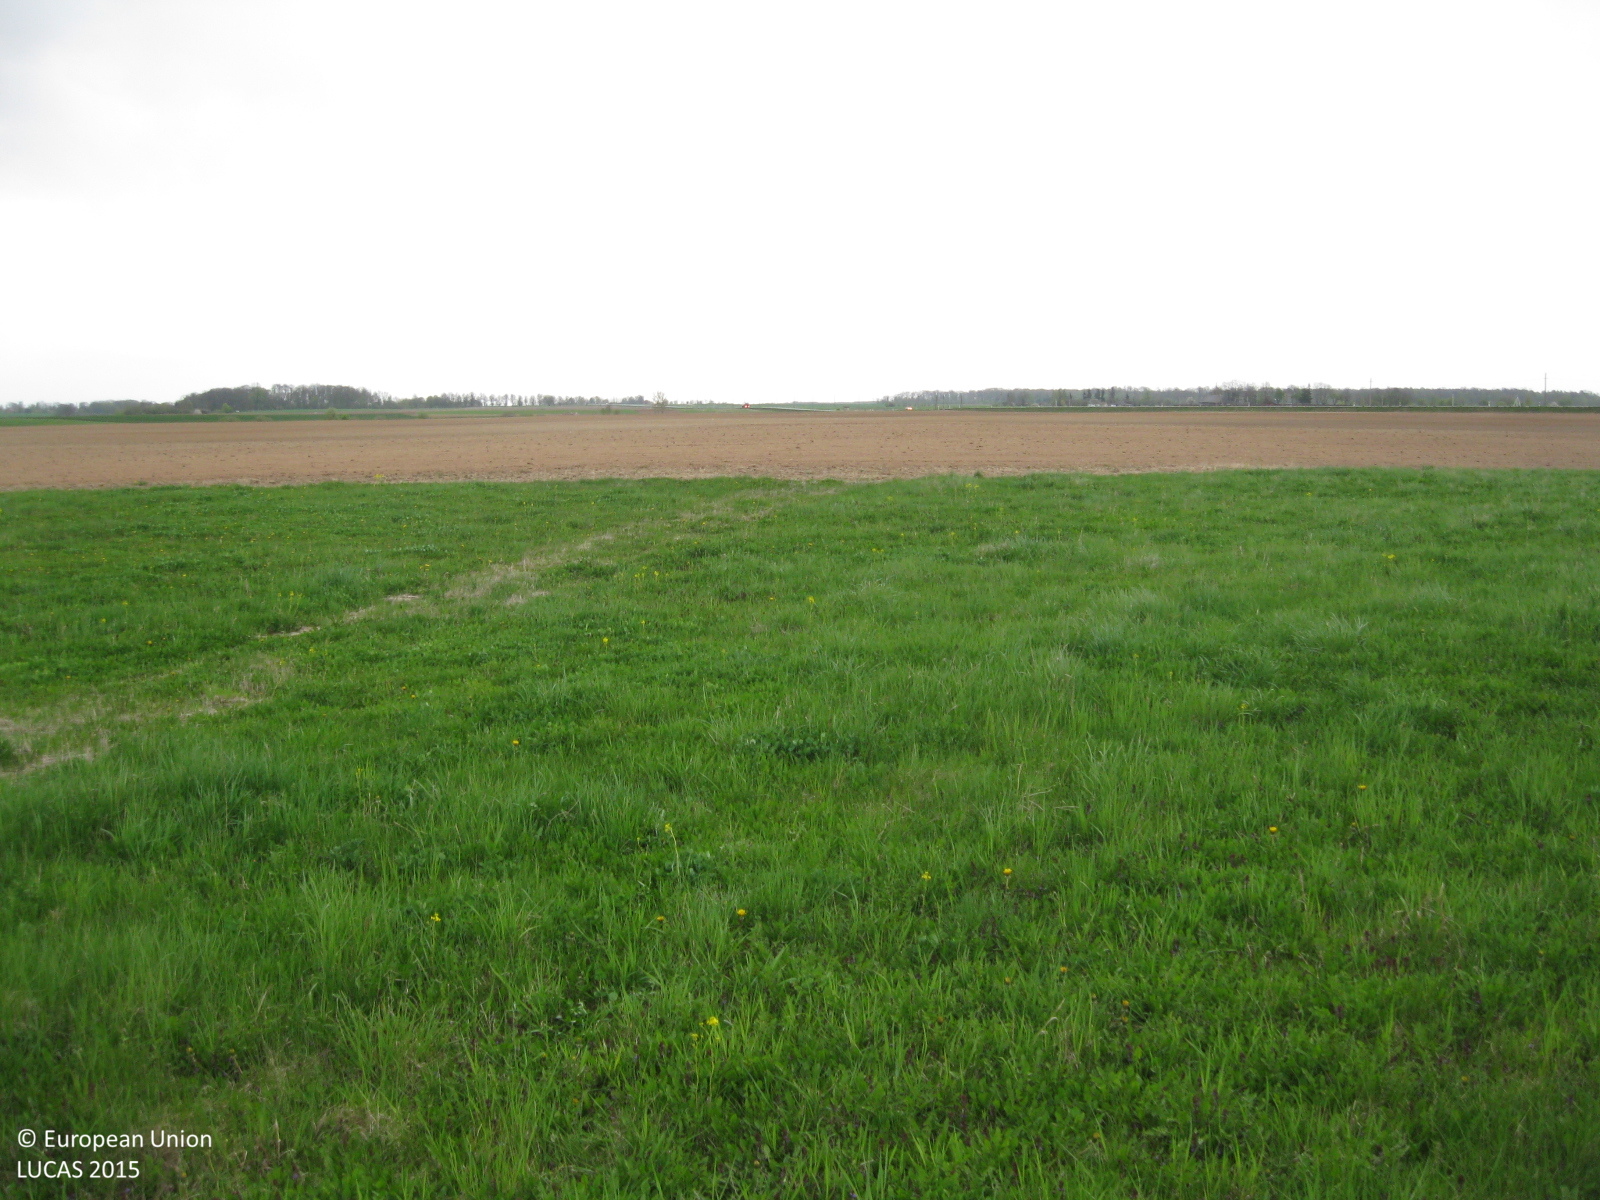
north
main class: Grassland
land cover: Grassland without tree/shrub cover
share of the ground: > 75 %
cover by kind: herbaceous plants 95 %, unconsolidated bare surface 5 %
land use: Agriculture (excluding fallow land and kitchen gardens)
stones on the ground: < 10 %
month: May
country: LT
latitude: 56.1308
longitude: 24.4644
